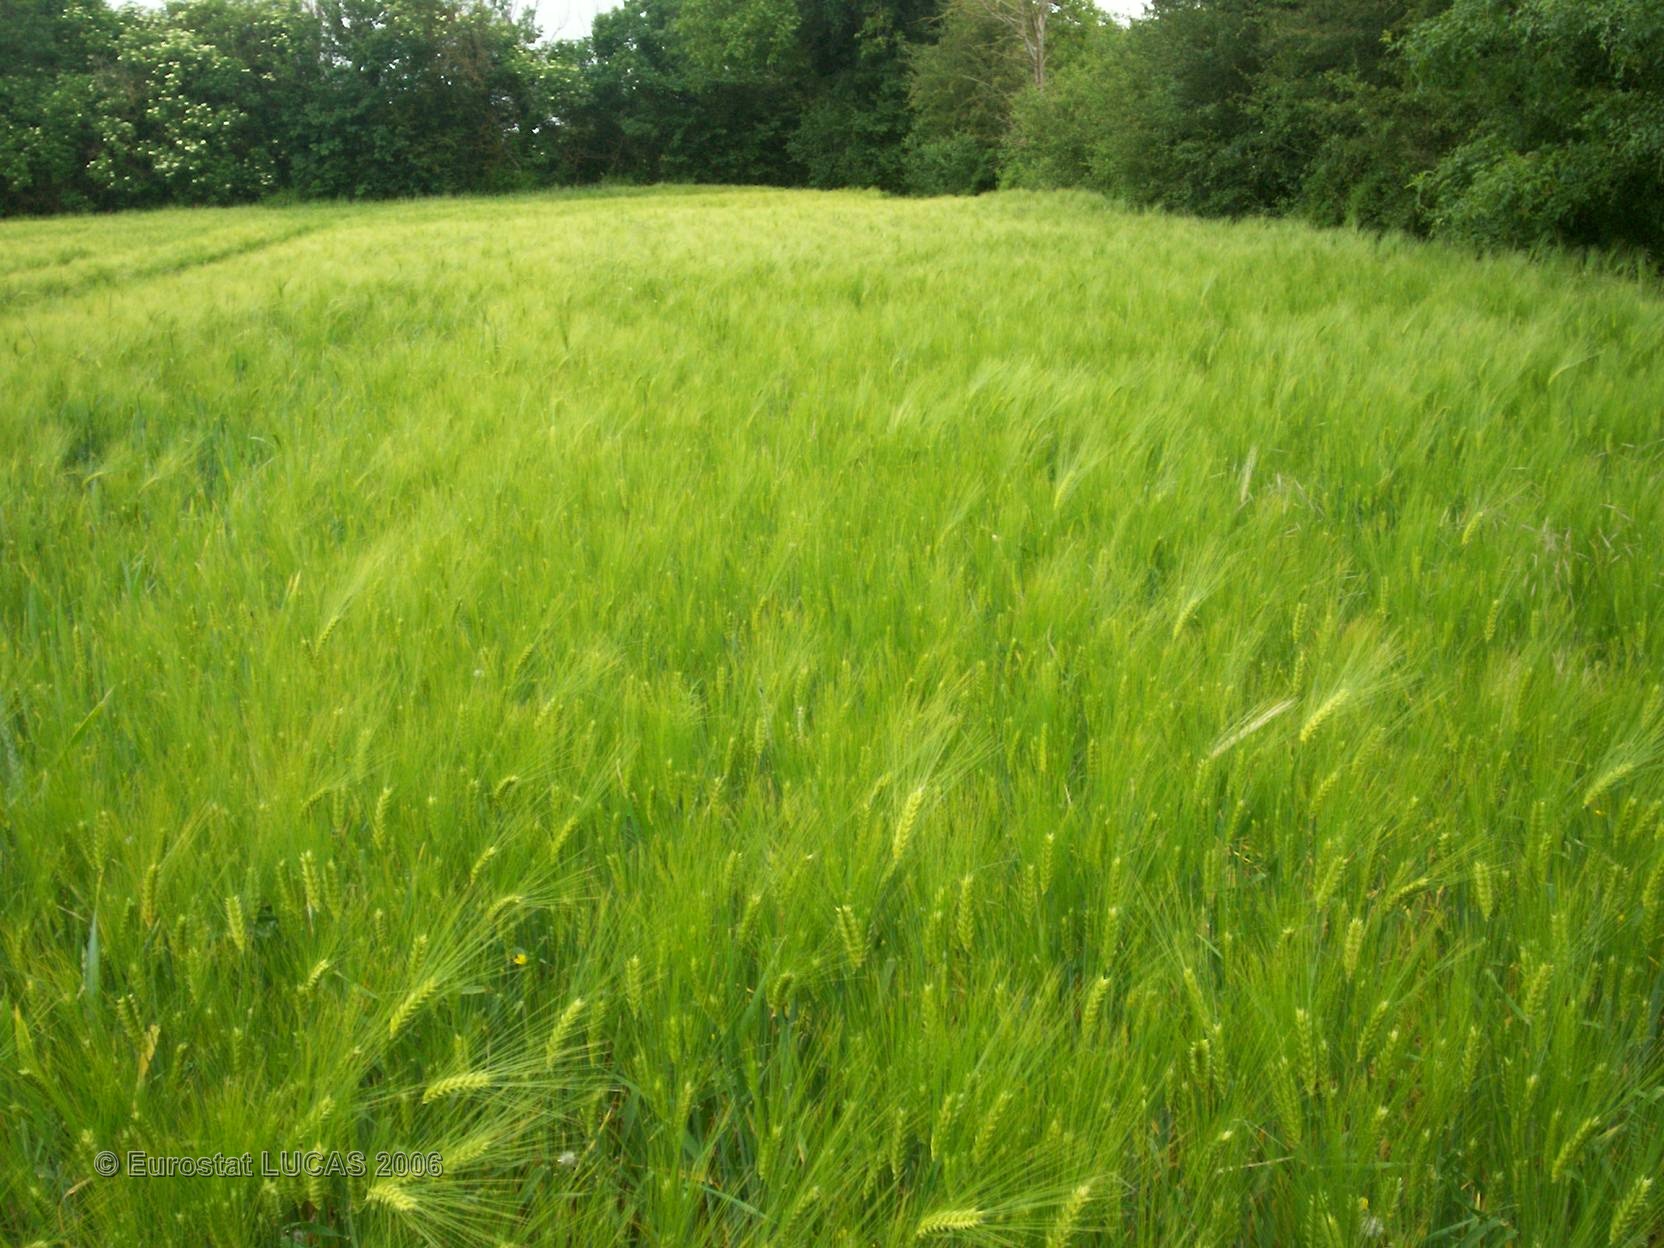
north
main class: Cropland
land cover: Barley
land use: Agriculture (excluding fallow land and kitchen gardens)
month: May
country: FR
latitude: 46.2919
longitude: 0.5206
